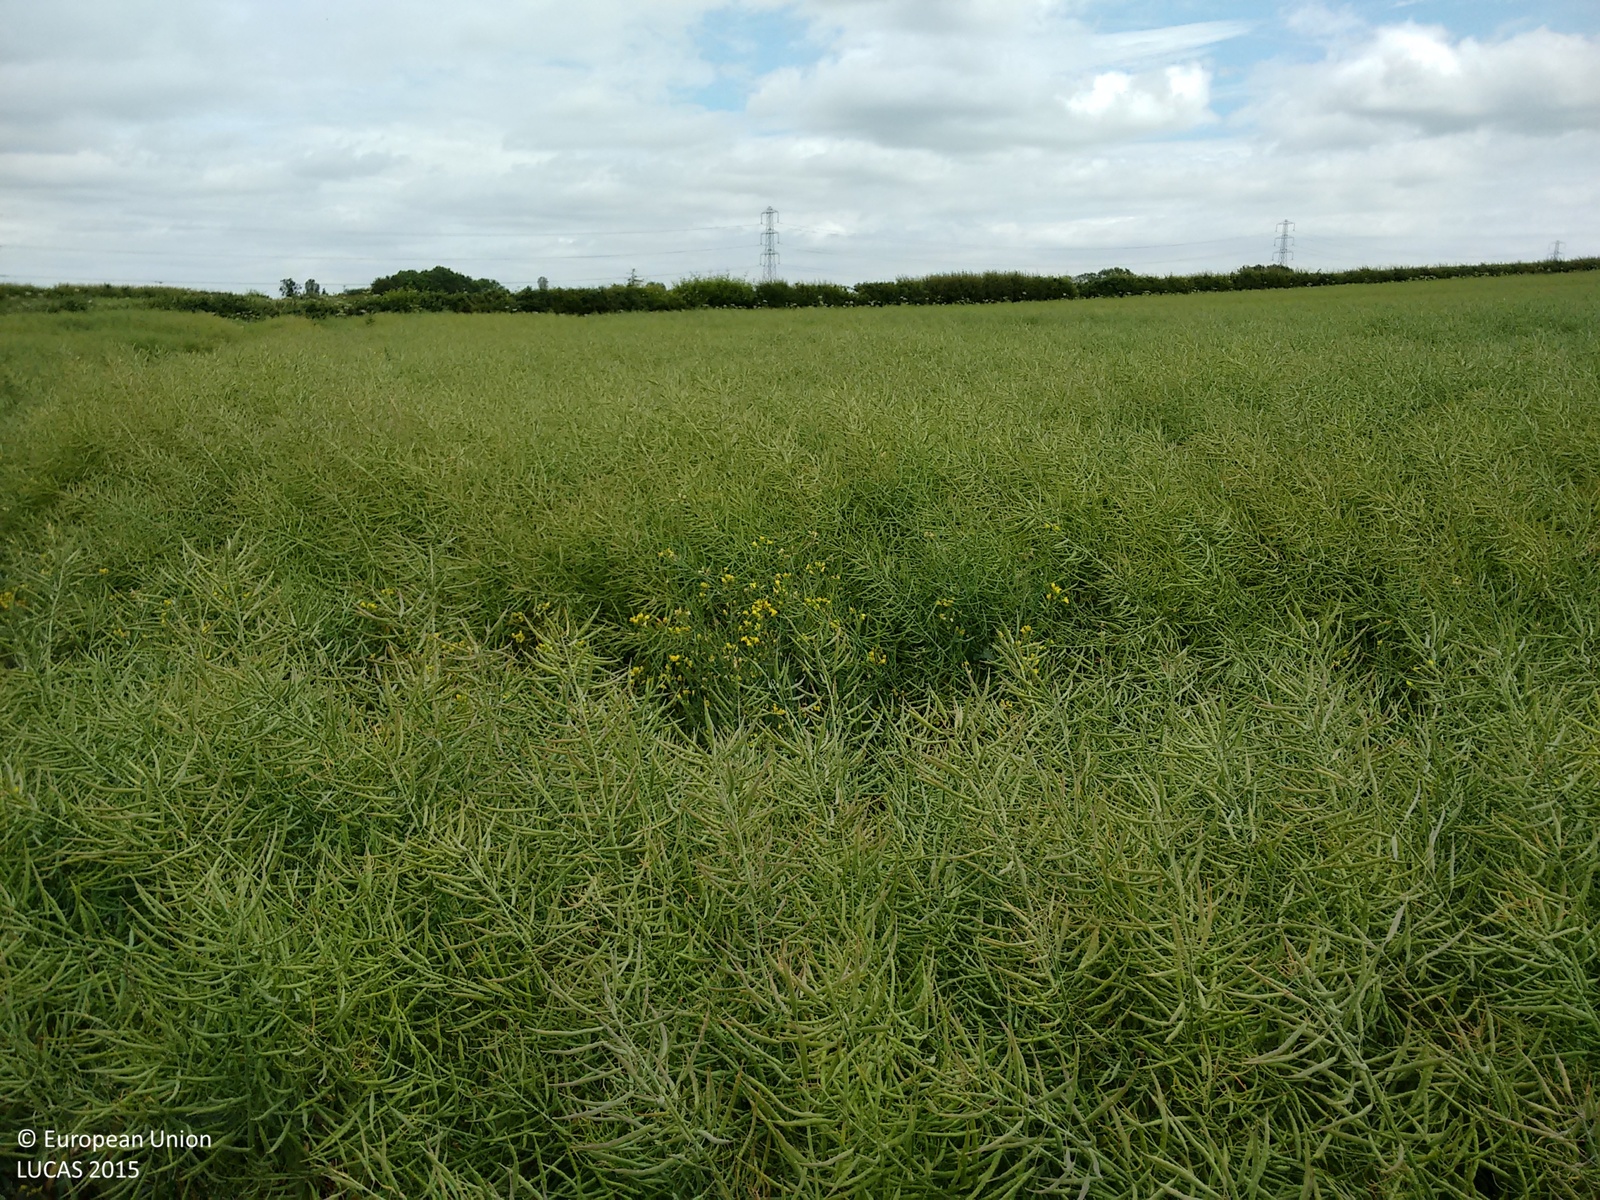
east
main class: Cropland
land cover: Rape and turnip rape
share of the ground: > 75 %
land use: Agriculture (excluding fallow land and kitchen gardens)
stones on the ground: < 10 %
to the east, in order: Rape and turnip rape; Grass margins; Managed hedges; Grass margins; Rape and turnip rape
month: June
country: GB
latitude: 52.1495
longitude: -0.6651
